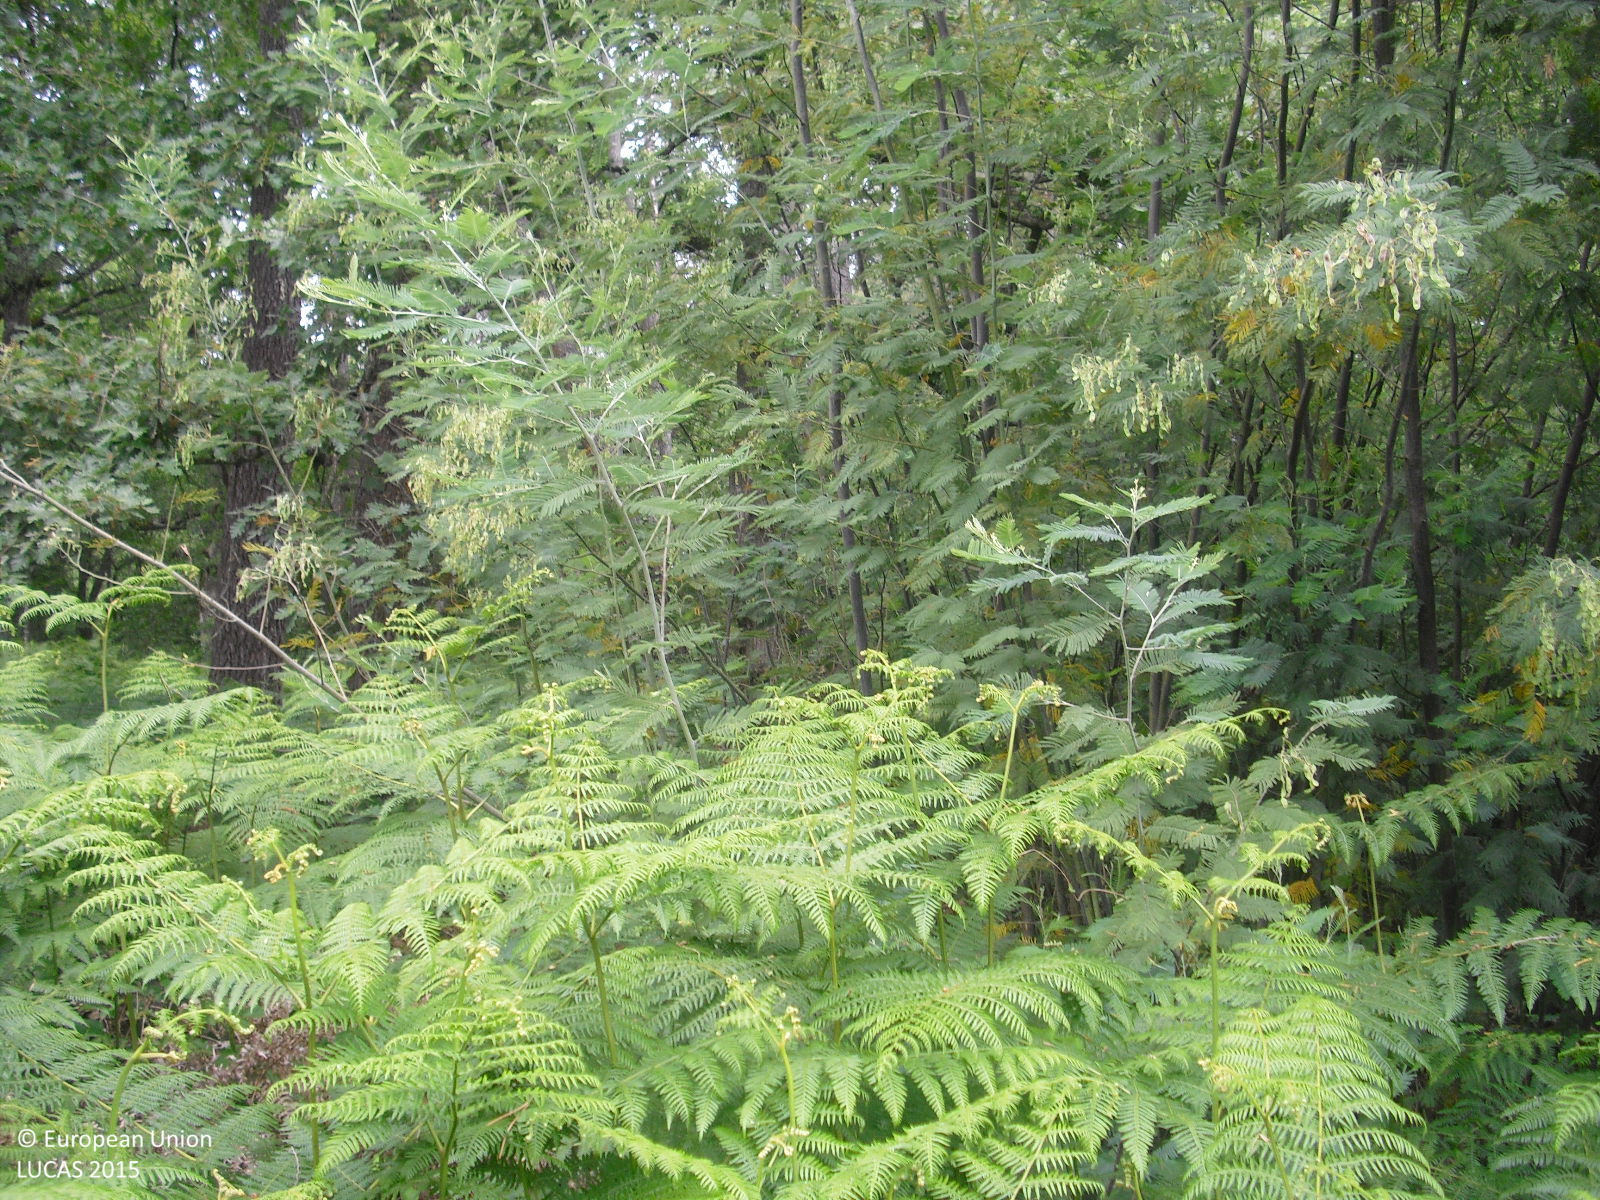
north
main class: Woodland
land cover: Broadleaved woodland
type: acidophilous oak and oak-birch forest
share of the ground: 25 - 50 %
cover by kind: shrubs 60 %, broadleaved forest trees 40 %
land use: Forestry
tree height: > 5 m
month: May
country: ES
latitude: 42.1992
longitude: -7.9406
